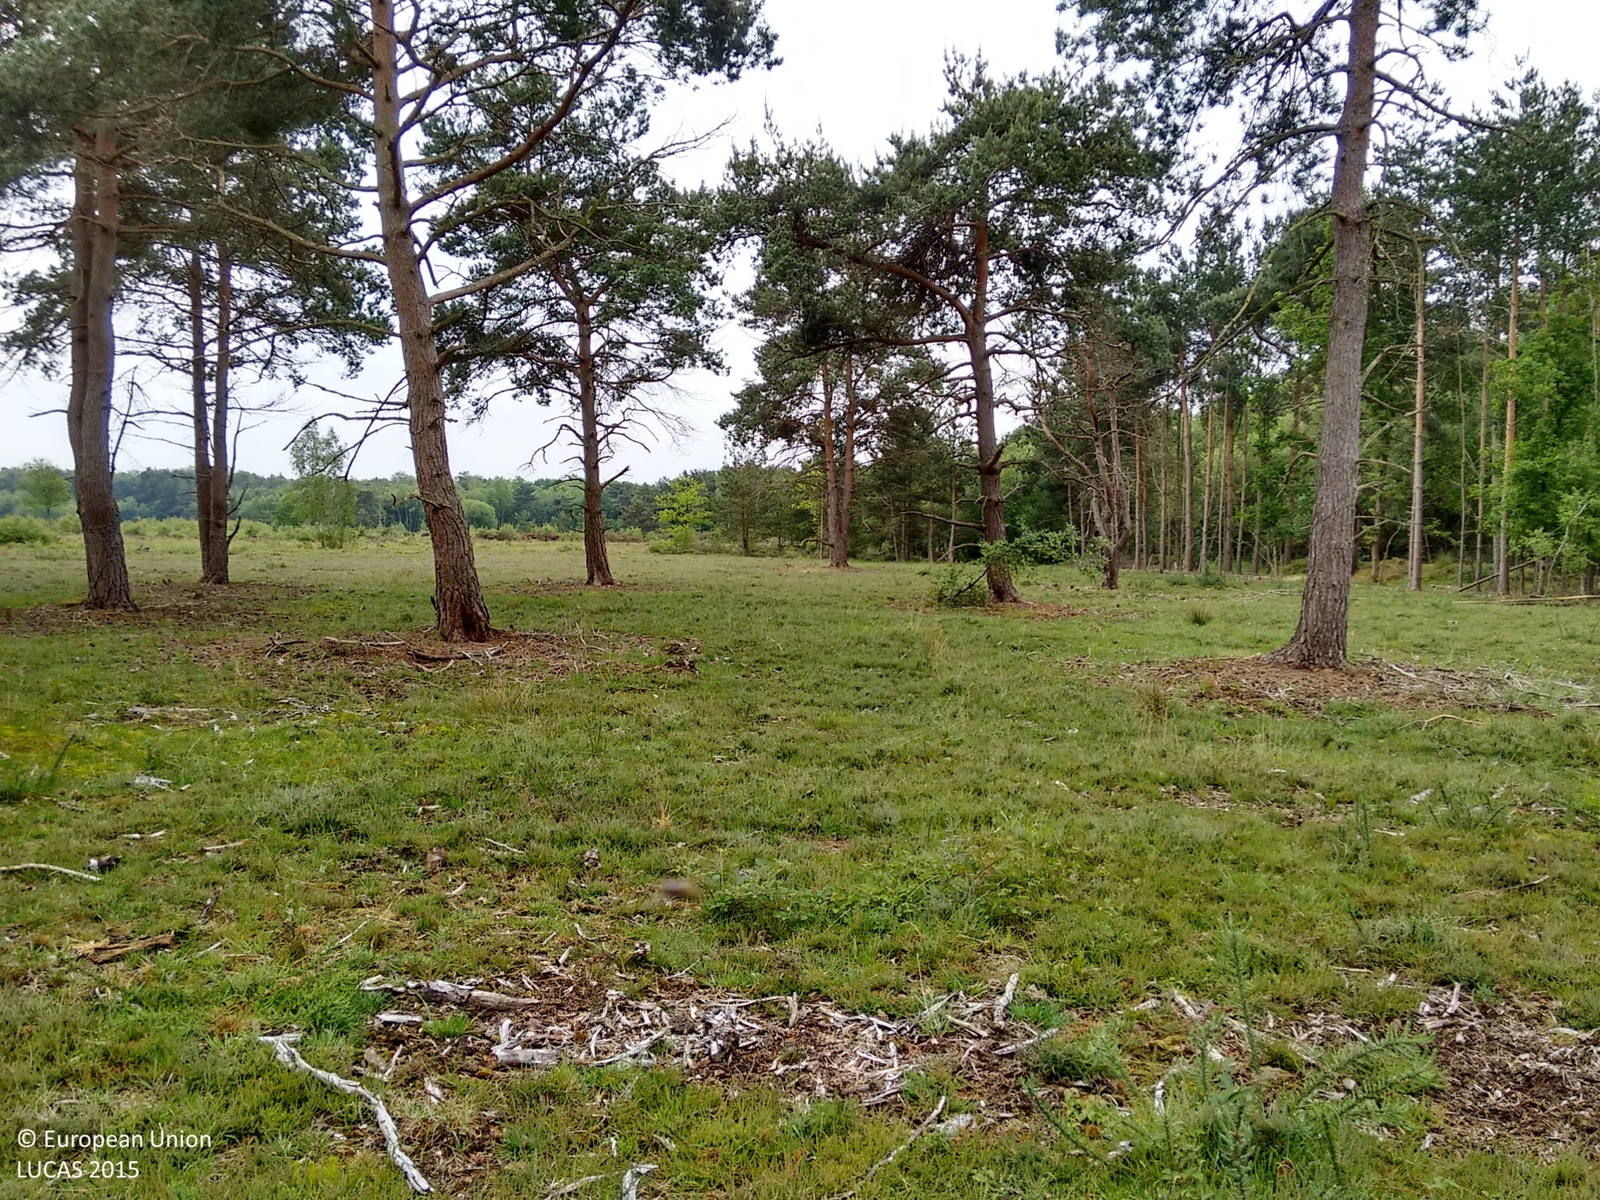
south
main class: Woodland
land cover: Other mixed woodland
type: mesophytic deciduous forest
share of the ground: 25 - 50 %
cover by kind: herbaceous plants 50 %, coniferous forest trees 30 %, broadleaved forest trees 20 %
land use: Forestry
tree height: < 5 m
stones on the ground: 10 - 25 %
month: June
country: GB
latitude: 51.5584
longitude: -0.5833
